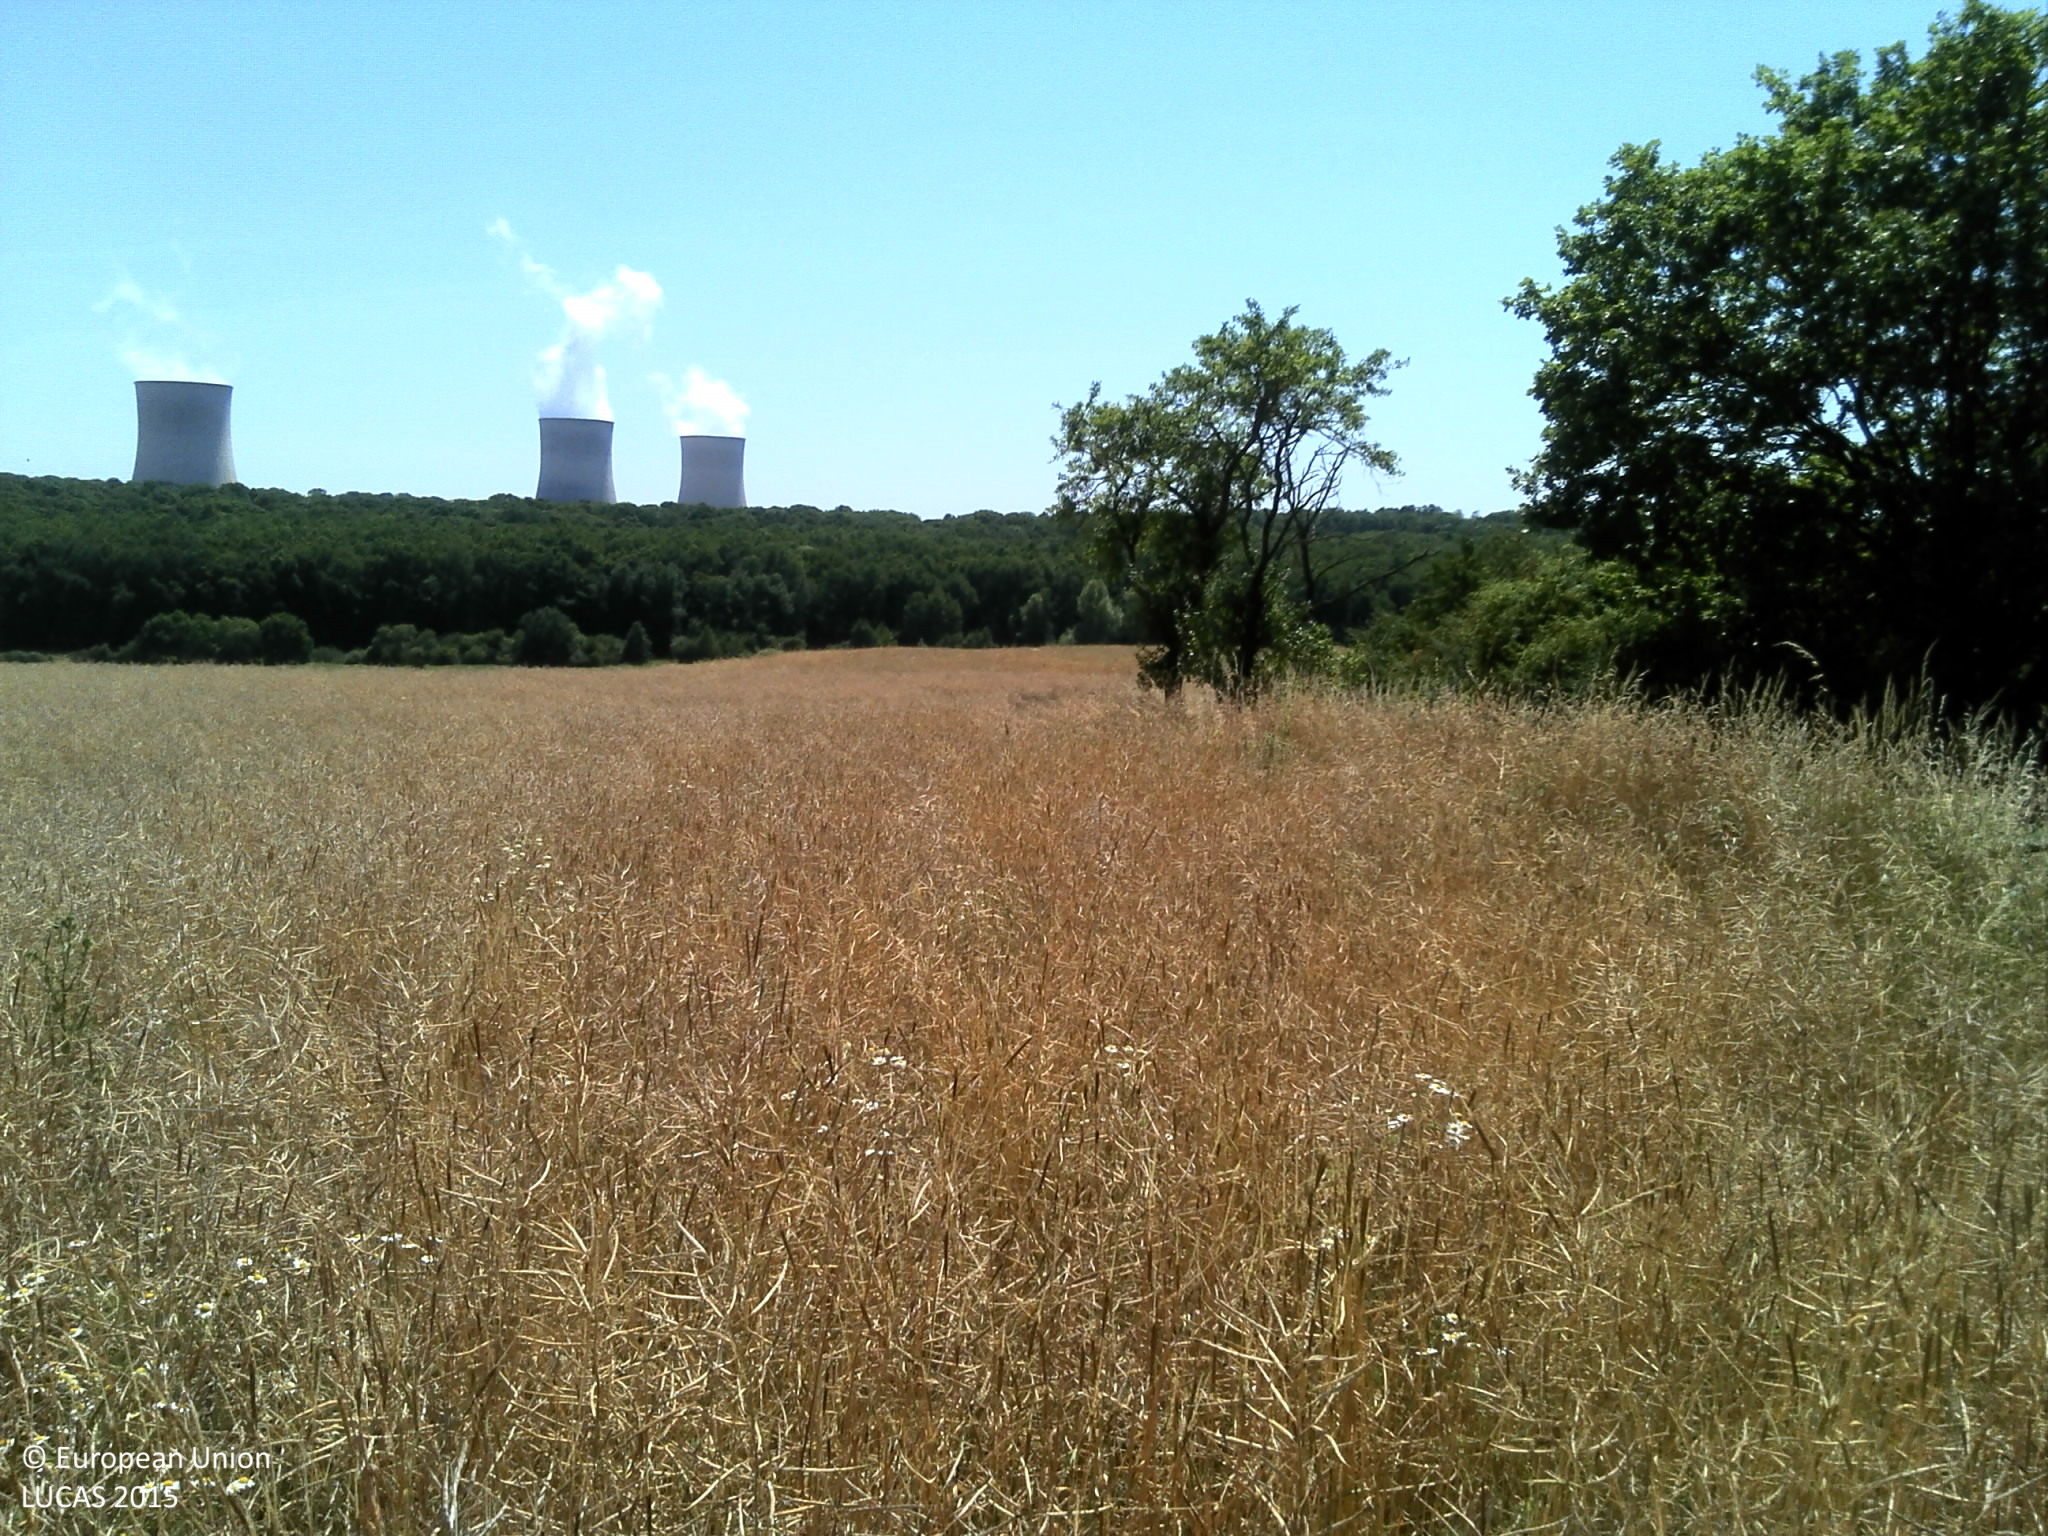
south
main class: Cropland
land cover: Rape and turnip rape
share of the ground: > 75 %
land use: Agriculture (excluding fallow land and kitchen gardens)
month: July
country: FR
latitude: 49.4370
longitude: 6.2073
